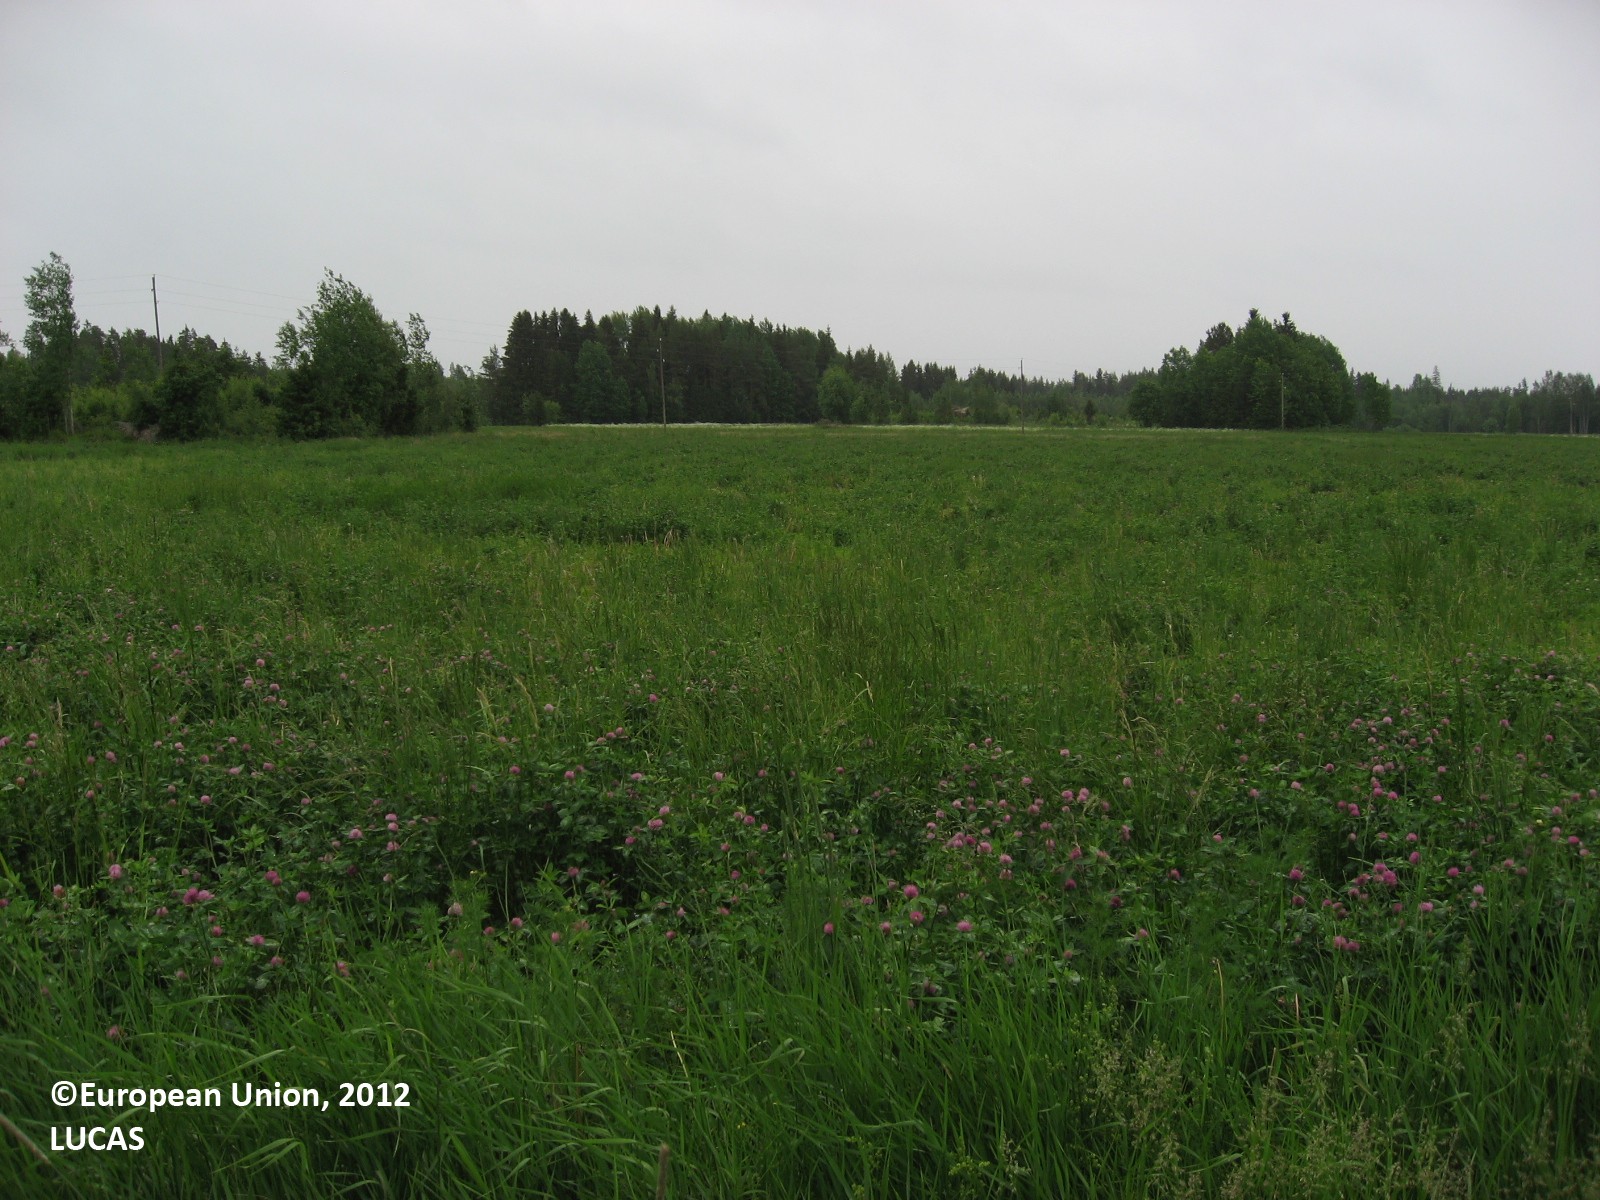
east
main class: Cropland
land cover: Clovers
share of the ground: > 75 %
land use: Agriculture (excluding fallow land and kitchen gardens)
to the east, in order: Clovers; Other leguminous and mixtures for fodder; Electric lines; Other leguminous and mixtures for fodder; Spontaneously vegetated surfaces; Spruce dominated mixed woodland
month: June
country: FI
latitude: 60.5174
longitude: 26.2699
